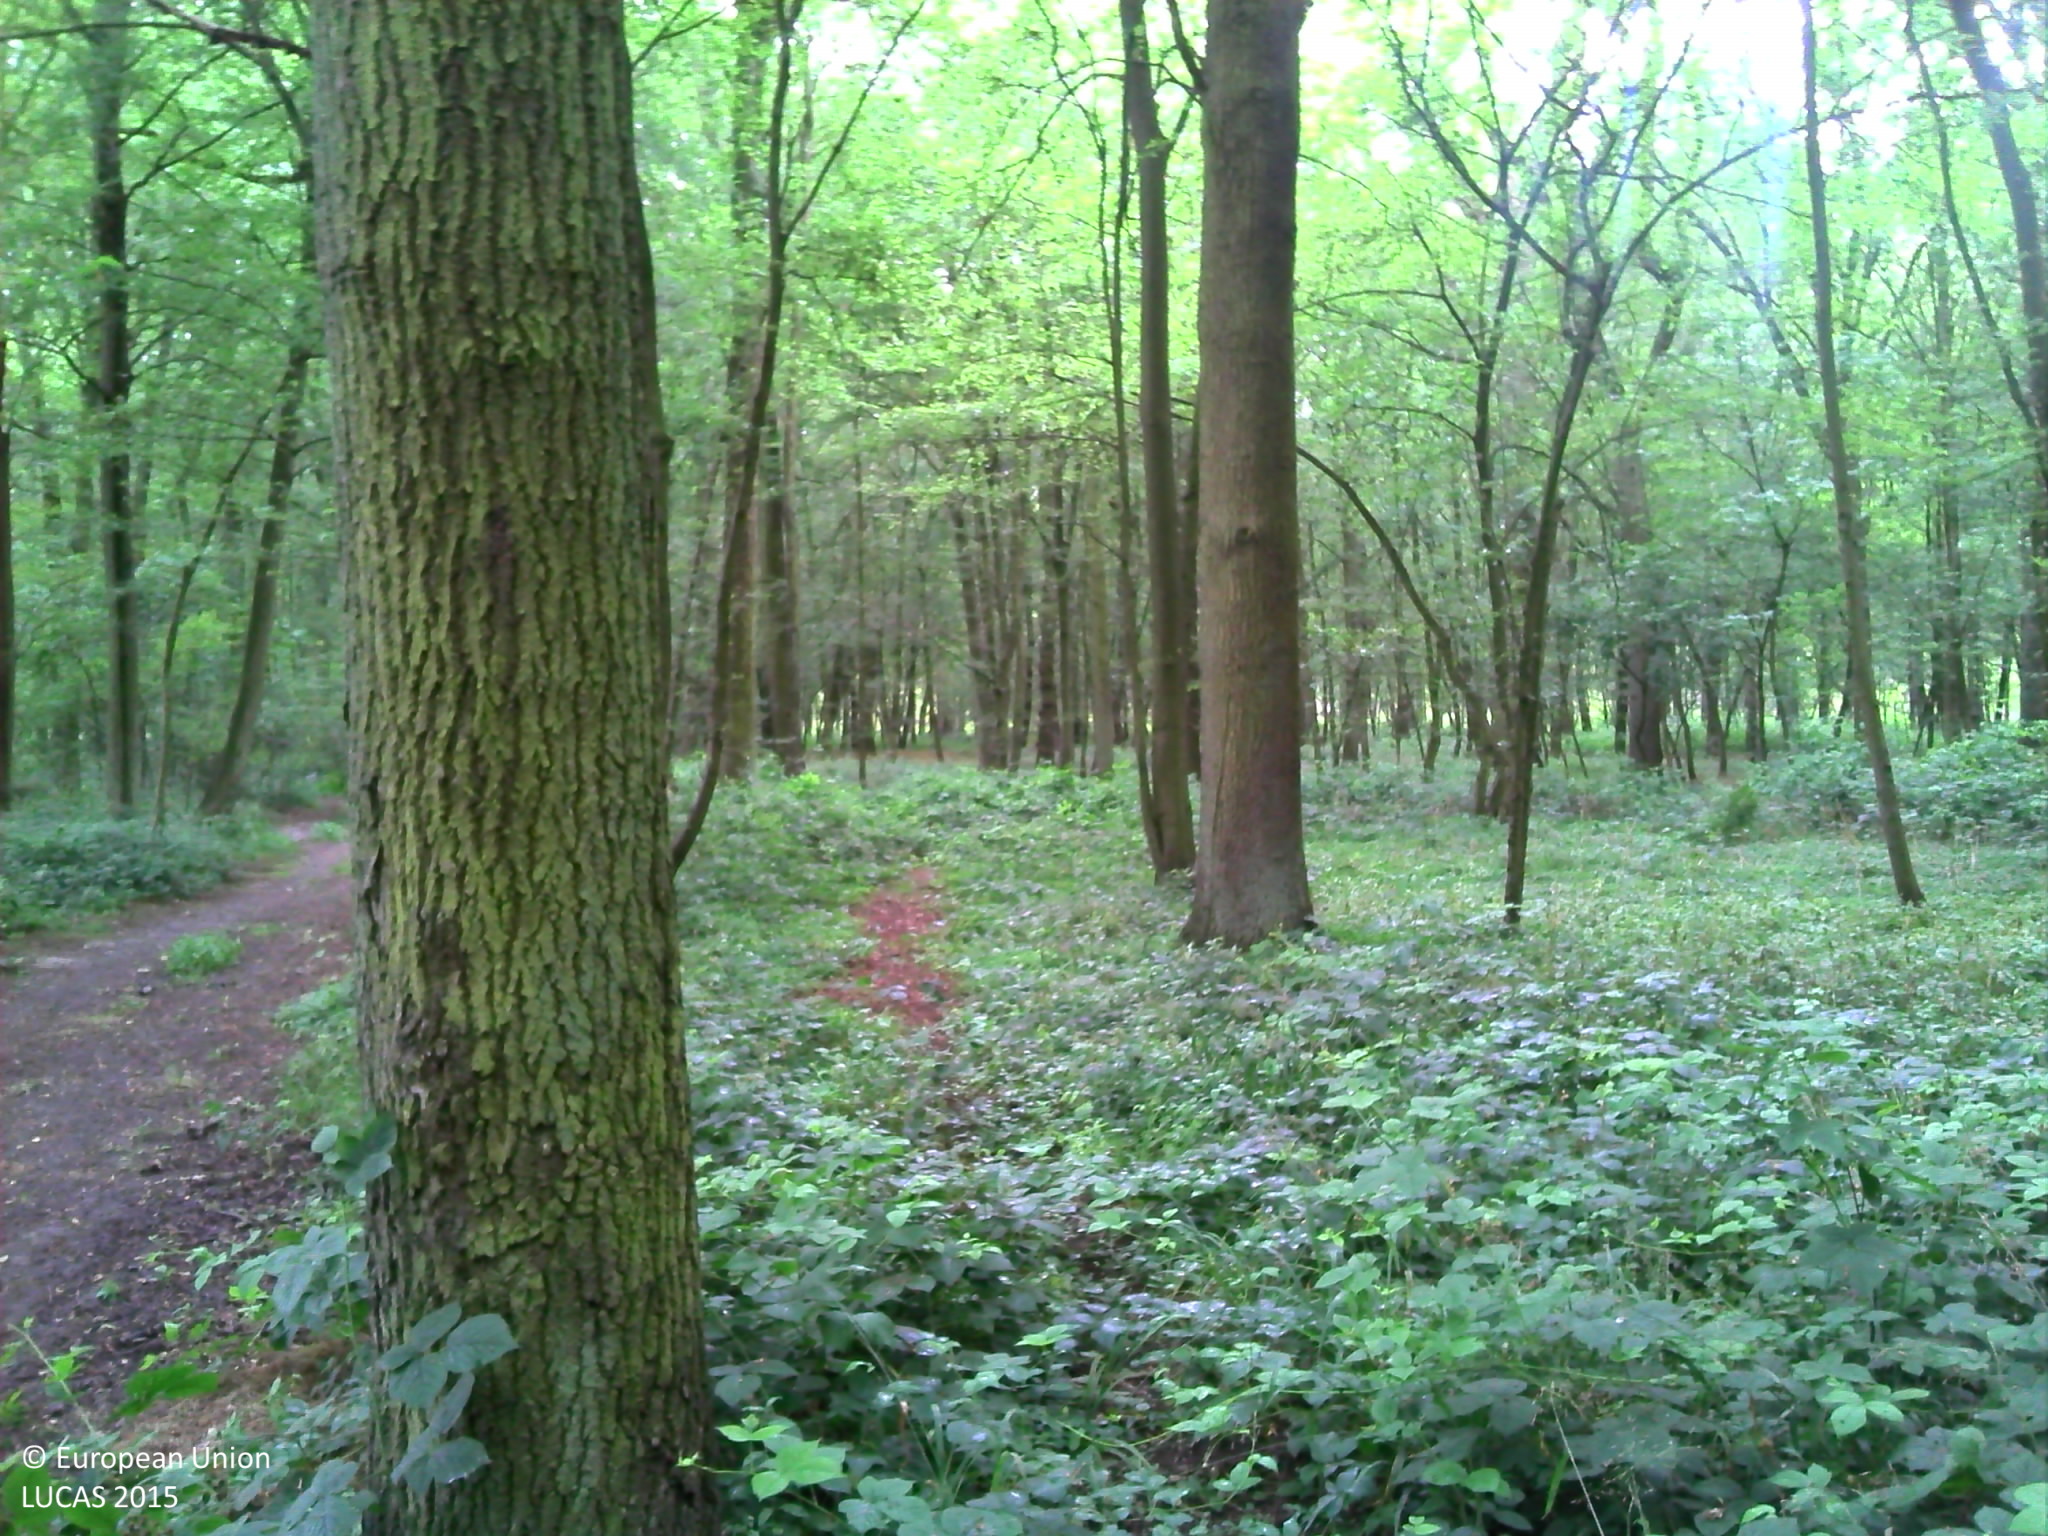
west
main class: Woodland
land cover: Broadleaved woodland
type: acidophilous oak and oak-birch forest
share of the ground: > 75 %
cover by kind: broadleaved forest trees 80 %, herbaceous plants 15 %, lichens and mosses 5 %
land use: Forestry
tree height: > 5 m
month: July
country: FR
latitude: 50.4966
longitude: 3.0686
